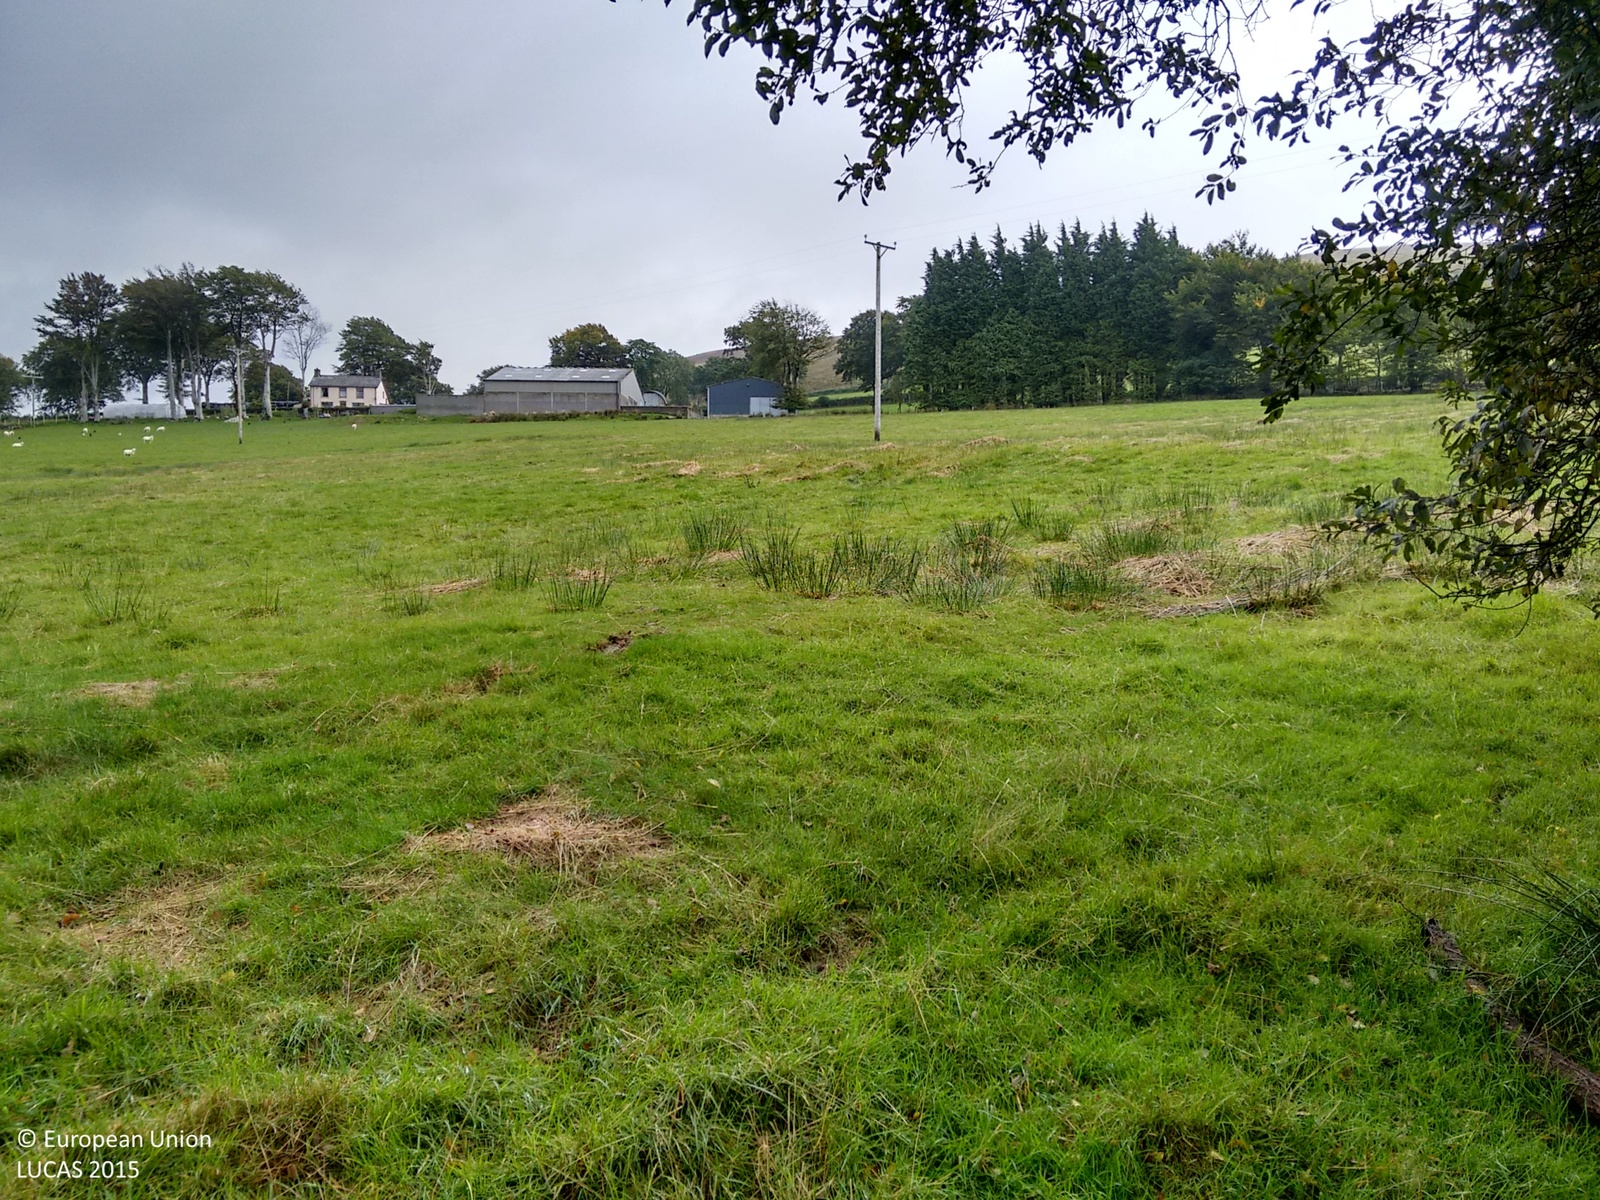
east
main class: Grassland
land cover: Grassland without tree/shrub cover
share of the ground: > 75 %
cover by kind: herbaceous plants 100 %
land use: Agriculture (excluding fallow land and kitchen gardens)
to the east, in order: Lines of trees; Grassland without tree/shrub cover; Electric lines; Grassland without tree/shrub cover; Ditches and canals; Lines of trees; Fences; Grassland without tree/shrub cover; Managed hedges; Fences; Grassland without tree/shrub cover; Fences; Managed hedges; Grass margins; Paved roads, cycling and walking lanes; Dry stone walls; Electric lines; Fences; Lines of trees; Grassland without tree/shrub cover
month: September
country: GB
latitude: 52.1879
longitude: -3.9455
